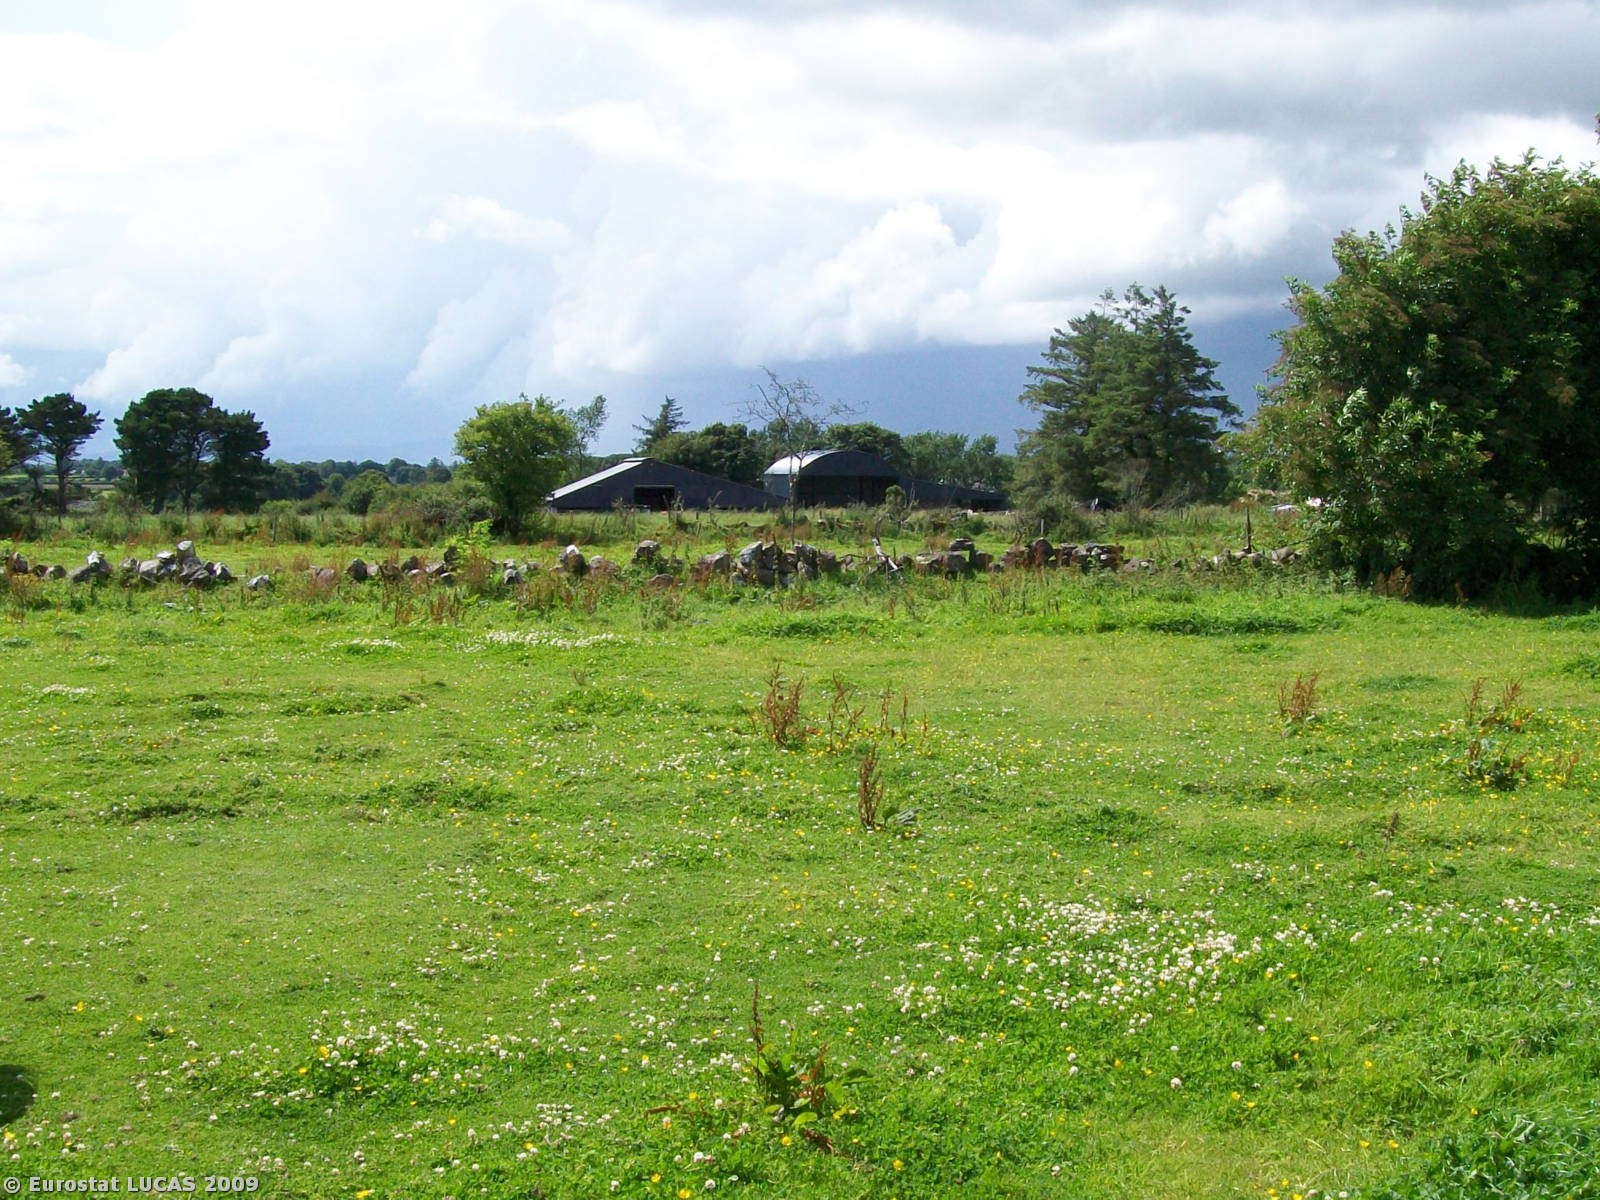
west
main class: Grassland
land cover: Grassland without tree/shrub cover
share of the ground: > 75 %
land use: Agriculture (excluding fallow land and kitchen gardens)
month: July
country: IE
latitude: 53.1592
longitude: -8.7325
